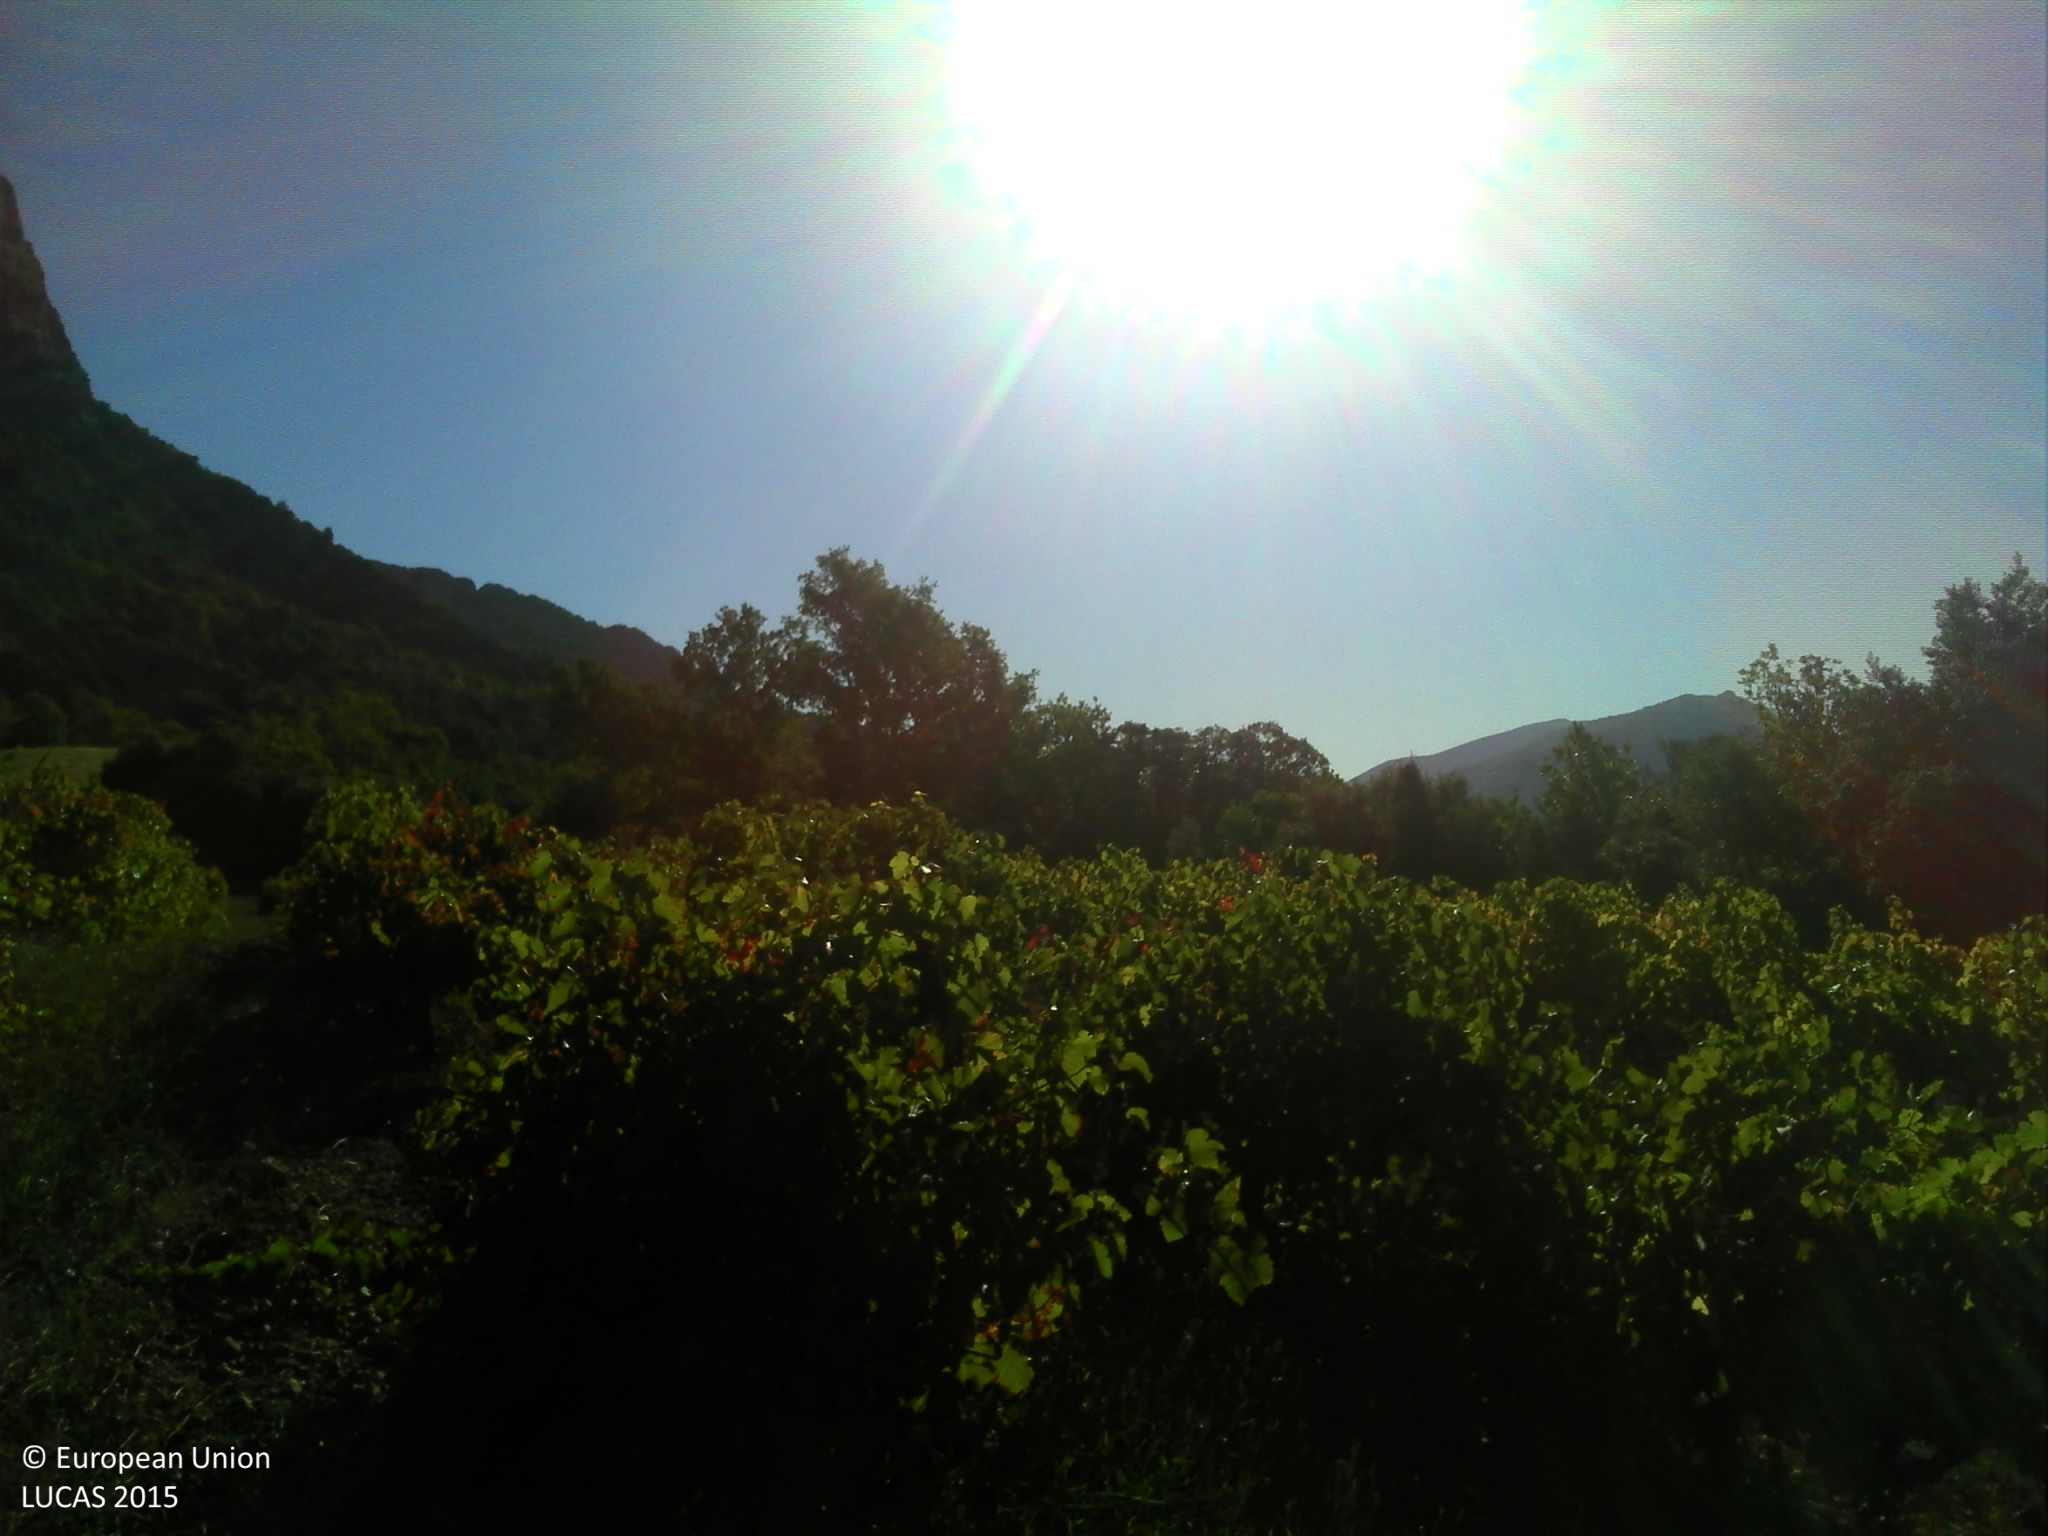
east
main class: Cropland
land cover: Vineyards
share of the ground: 25 - 50 %
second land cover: Other bare soil
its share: > 75 %
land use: Agriculture (excluding fallow land and kitchen gardens)
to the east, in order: Vineyards; Other bare soil; Broadleaved woodland
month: September
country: FR
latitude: 44.2952
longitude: 5.2324
